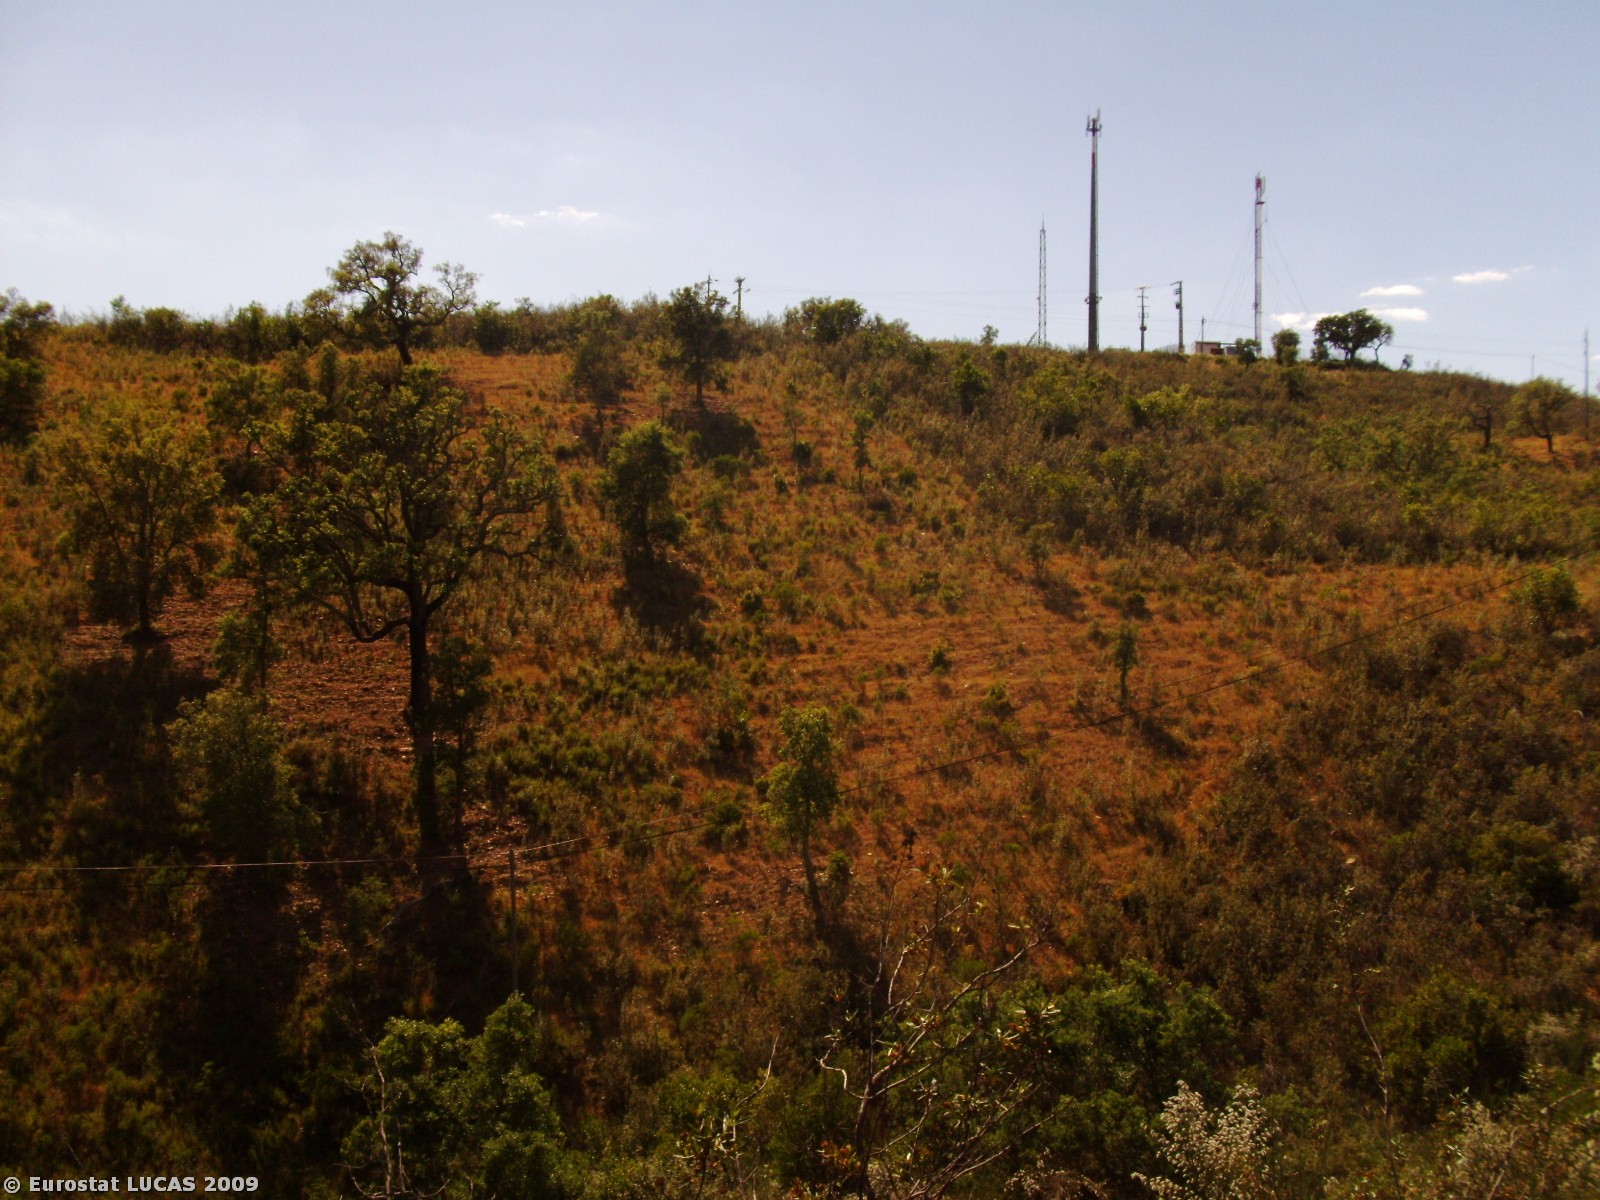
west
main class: Shrubland
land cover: Shrubland without tree cover
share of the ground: > 75 %
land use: Unused
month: May
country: PT
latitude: 37.4723
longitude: -8.3112
